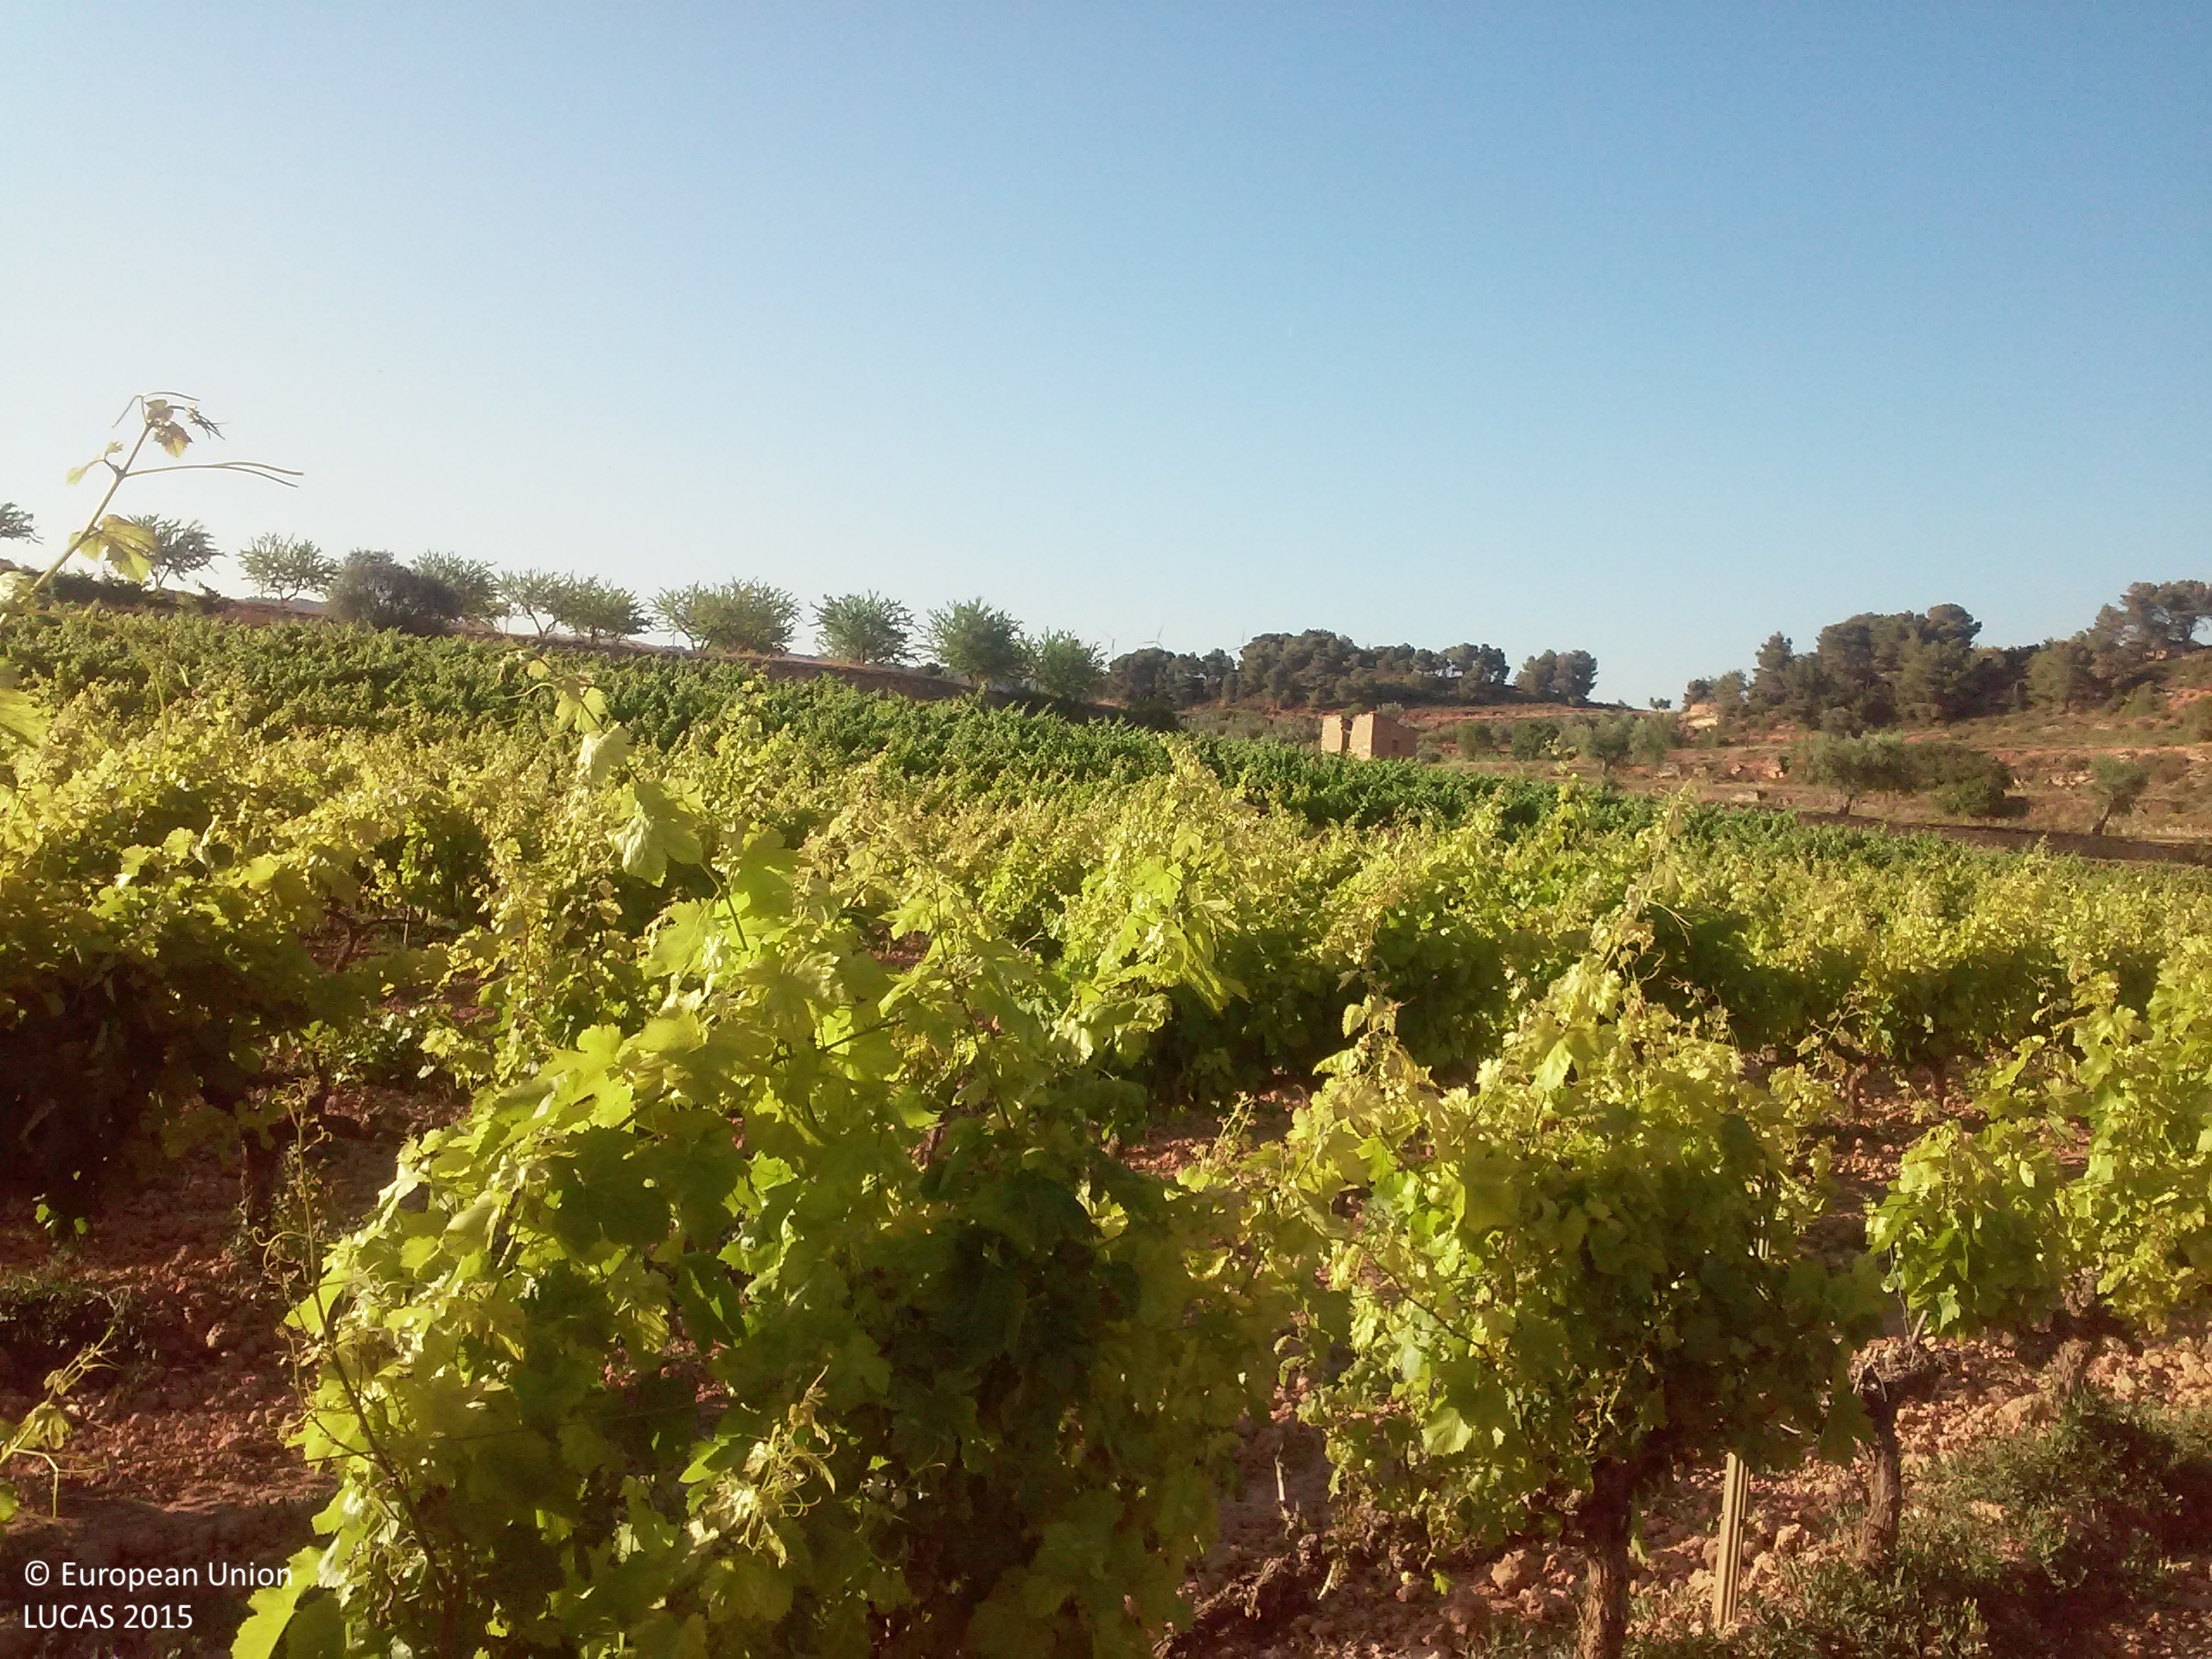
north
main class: Cropland
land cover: Vineyards
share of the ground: 10 - 25 %
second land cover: Other bare soil
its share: > 75 %
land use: Agriculture (excluding fallow land and kitchen gardens)
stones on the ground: 10 - 25 %
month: June
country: ES
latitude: 41.4524
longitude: 1.1927
